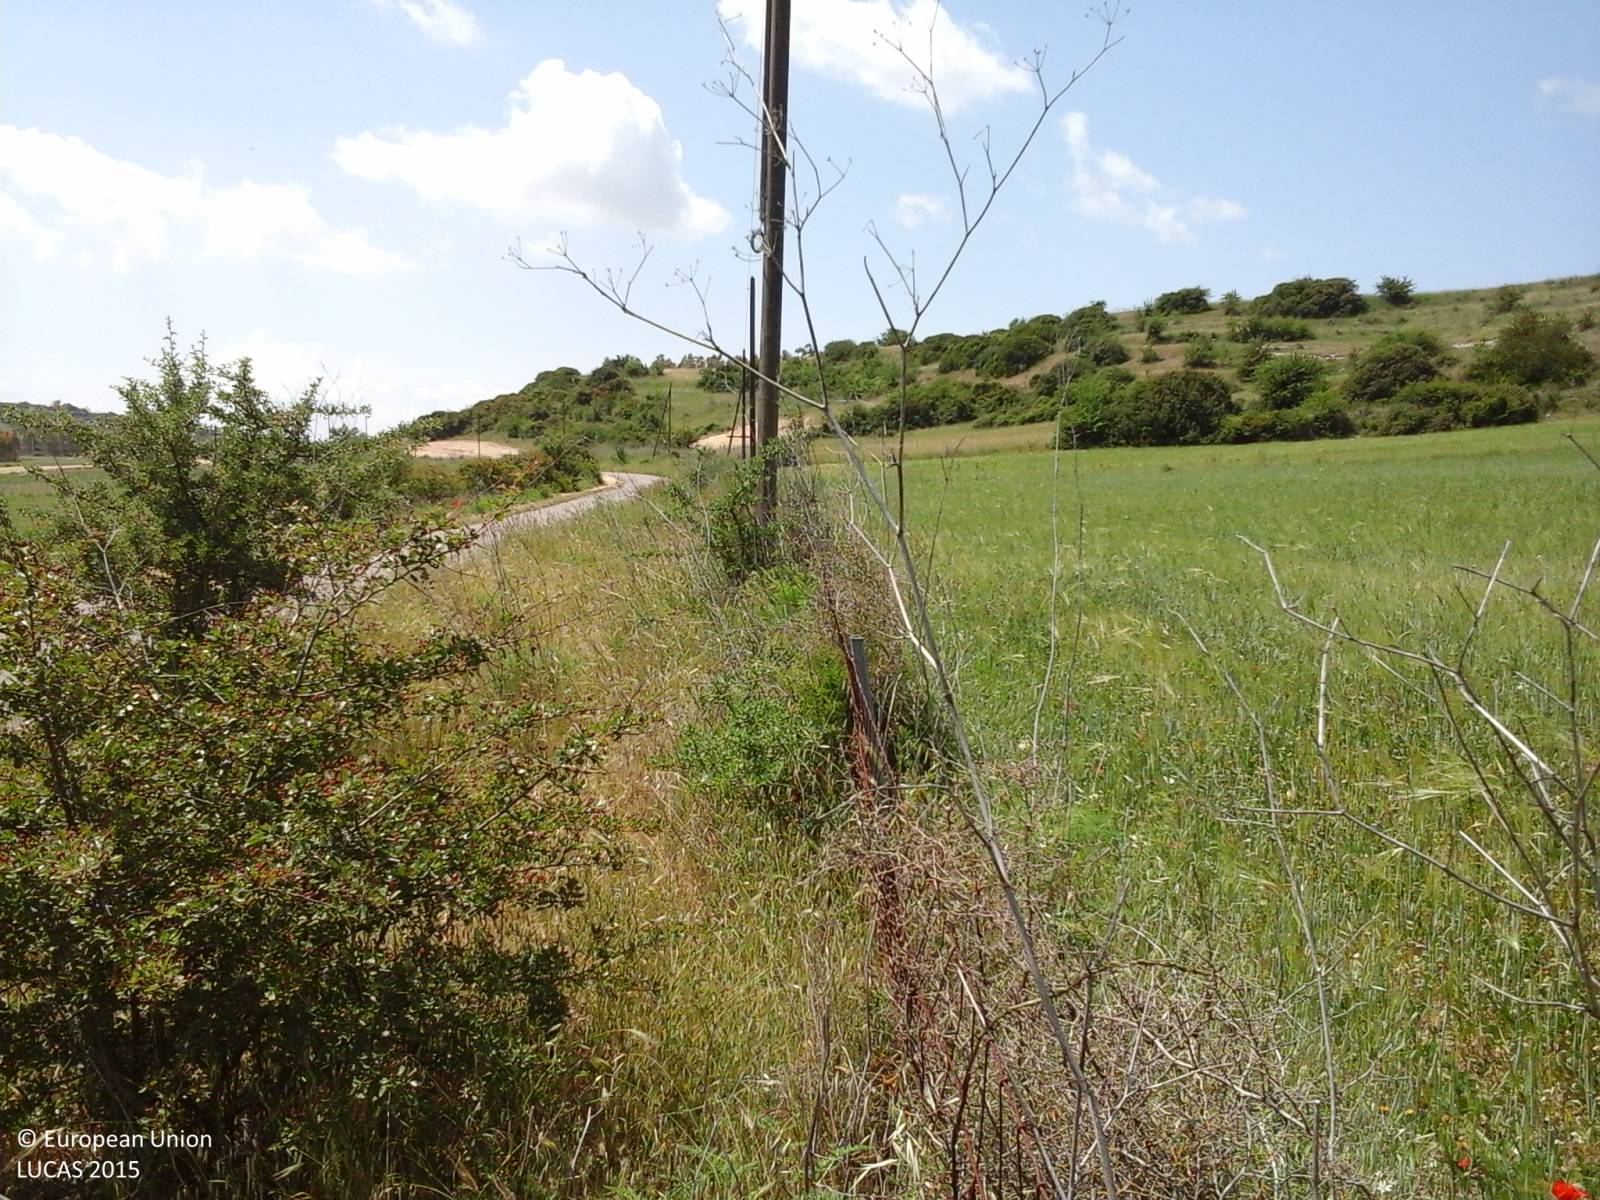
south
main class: Cropland
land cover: Other leguminous and mixtures for fodder
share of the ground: > 75 %
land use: Agriculture (excluding fallow land and kitchen gardens)
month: May
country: IT
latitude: 39.8082
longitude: 8.8733
